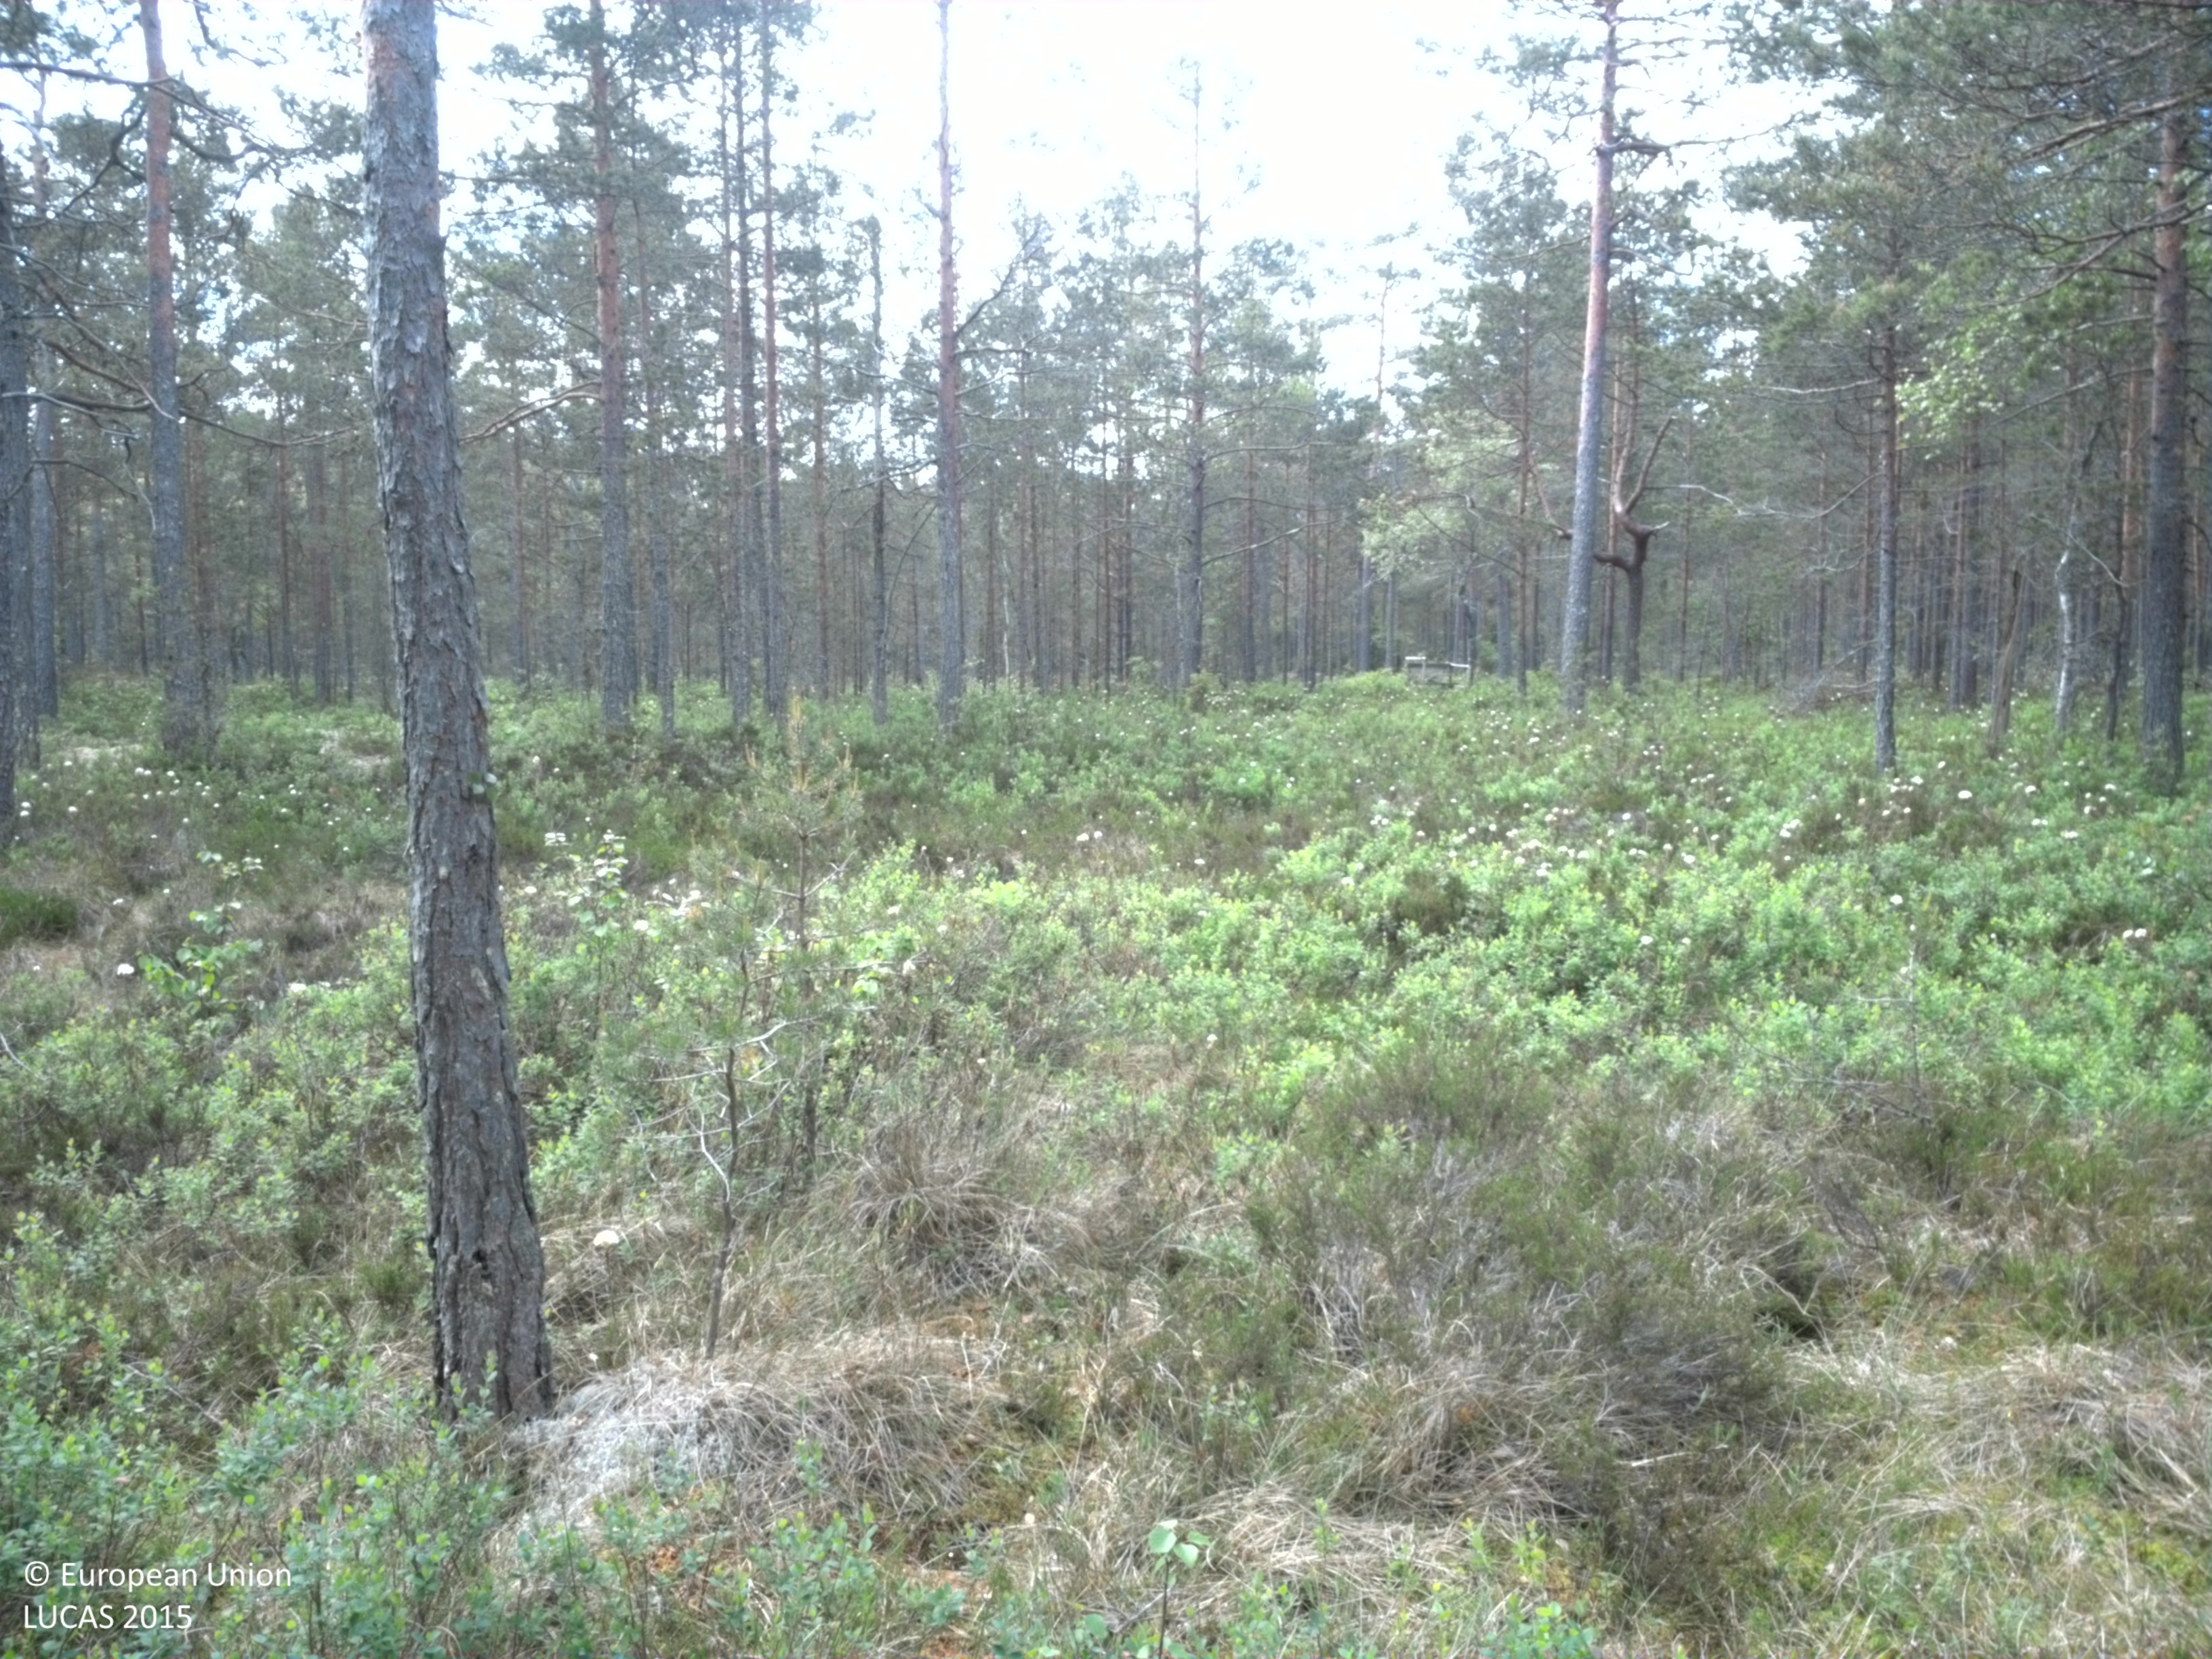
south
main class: Woodland
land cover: Pine dominated coniferous woodland
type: boreal forest
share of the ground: 25 - 50 %
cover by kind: lichens and mosses 50 %, coniferous forest trees 25 %, herbaceous plants 20 %, broadleaved forest trees 5 %
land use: Forestry
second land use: Amenities, museums, leisure
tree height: > 5 m
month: June
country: SE
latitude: 59.9297
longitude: 17.0955
